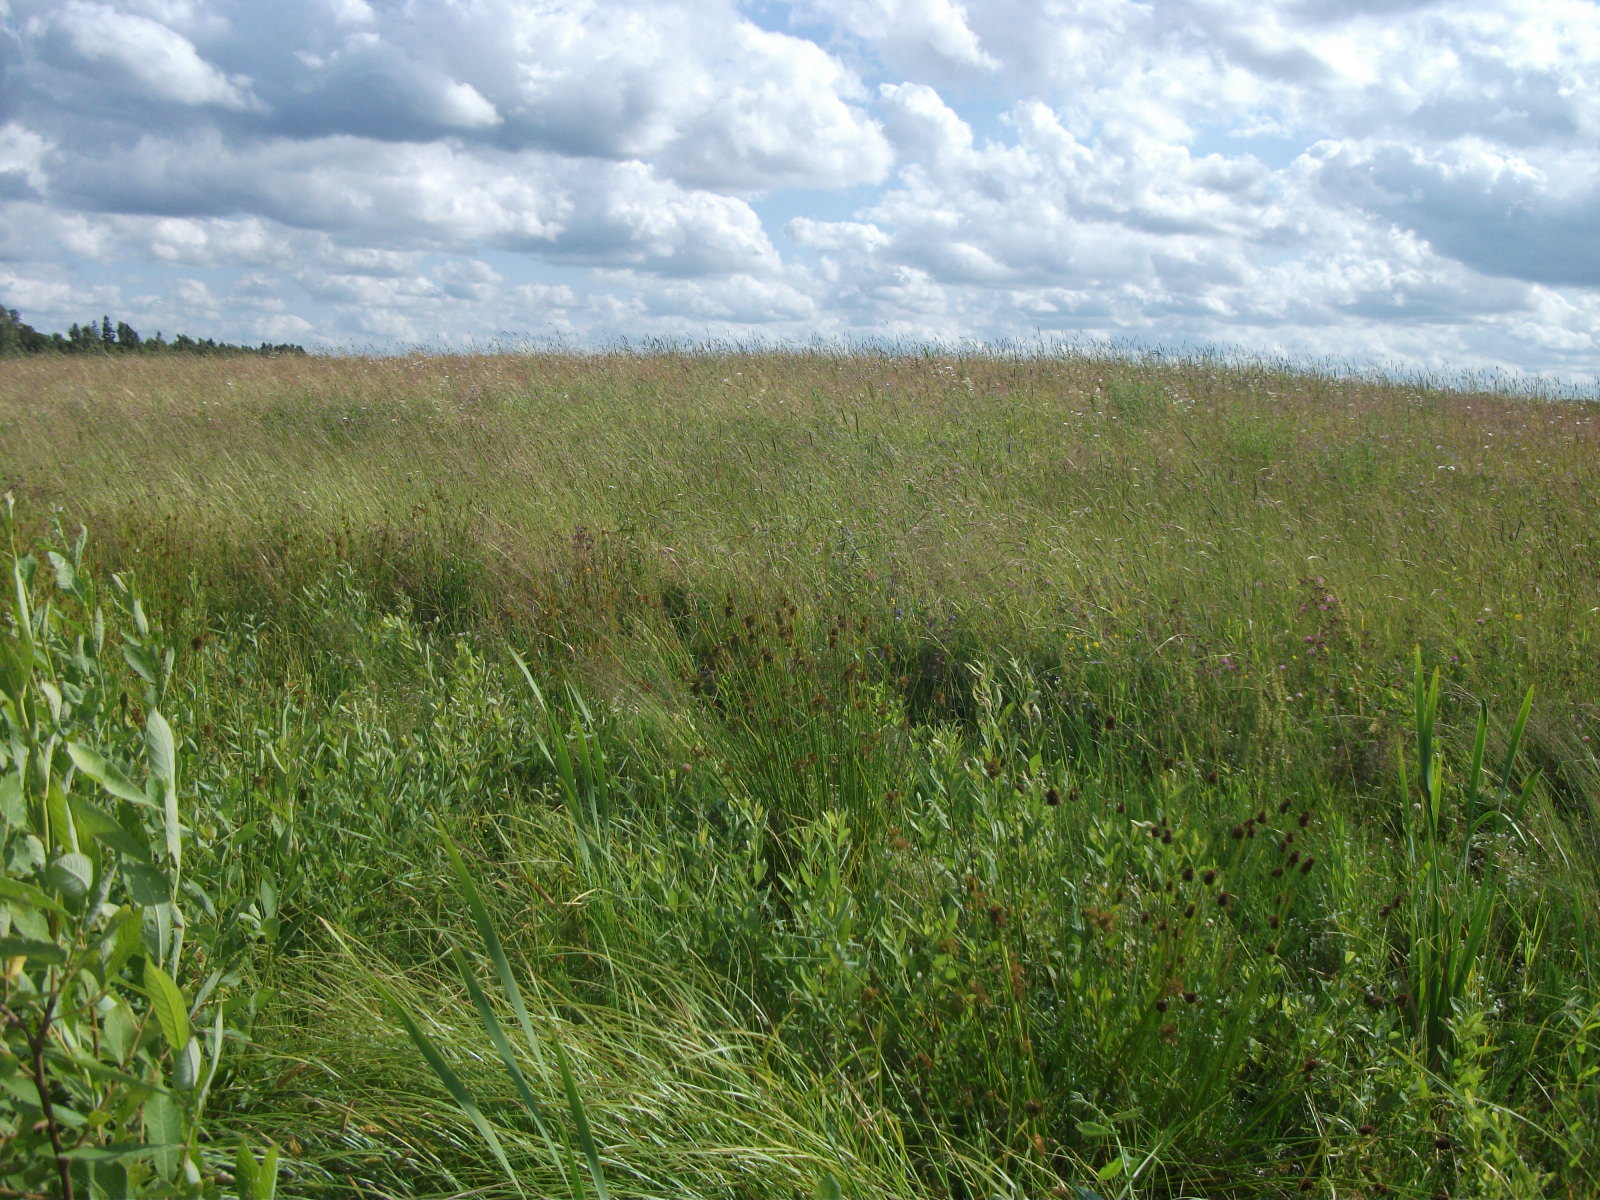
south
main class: Woodland
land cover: Broadleaved woodland
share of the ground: 50 - 75 %
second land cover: Spontaneously vegetated surfaces
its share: 50 - 75 %
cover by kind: broadleaved forest trees 50 %, shrubs 30 %, herbaceous plants 20 %
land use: Agriculture (excluding fallow land and kitchen gardens)
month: July
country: LV
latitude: 57.1650
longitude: 25.9539
